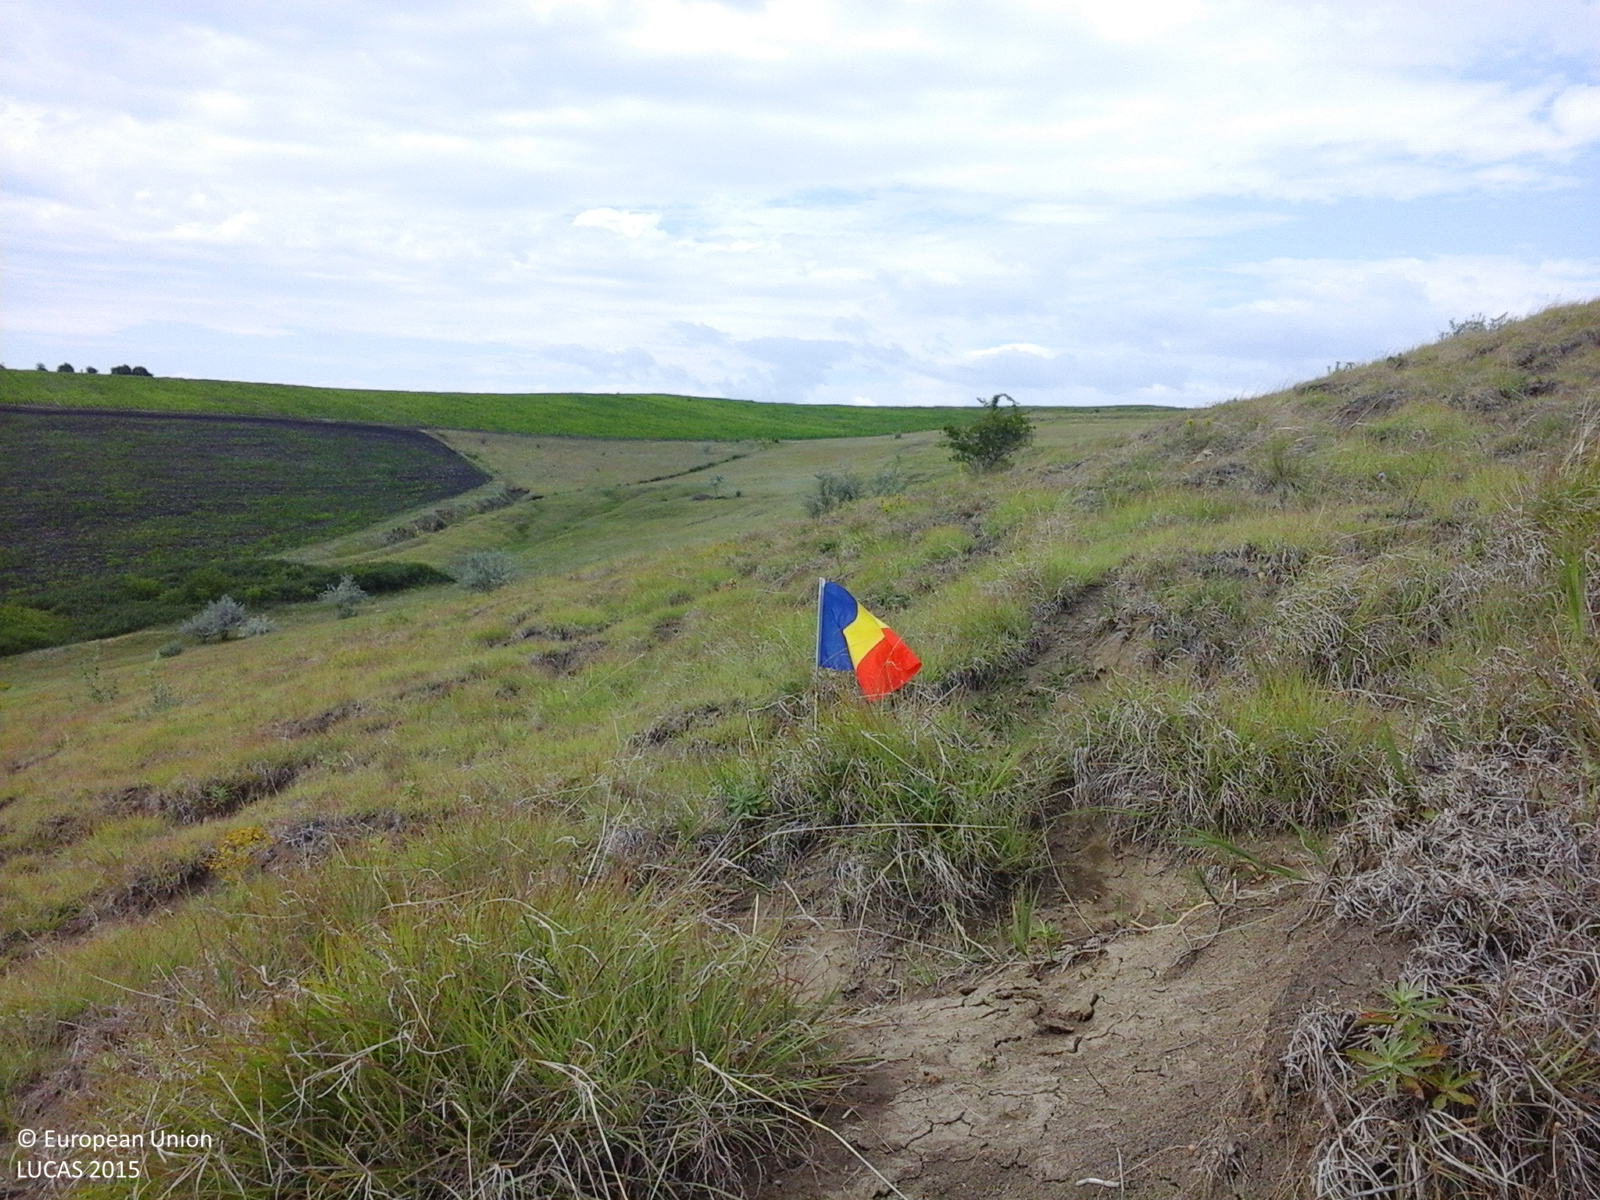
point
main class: Grassland
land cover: Grassland without tree/shrub cover
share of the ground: 50 - 75 %
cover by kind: herbaceous plants 100 %
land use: Agriculture (excluding fallow land and kitchen gardens)
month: June
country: RO
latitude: 46.7048
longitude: 27.6836
